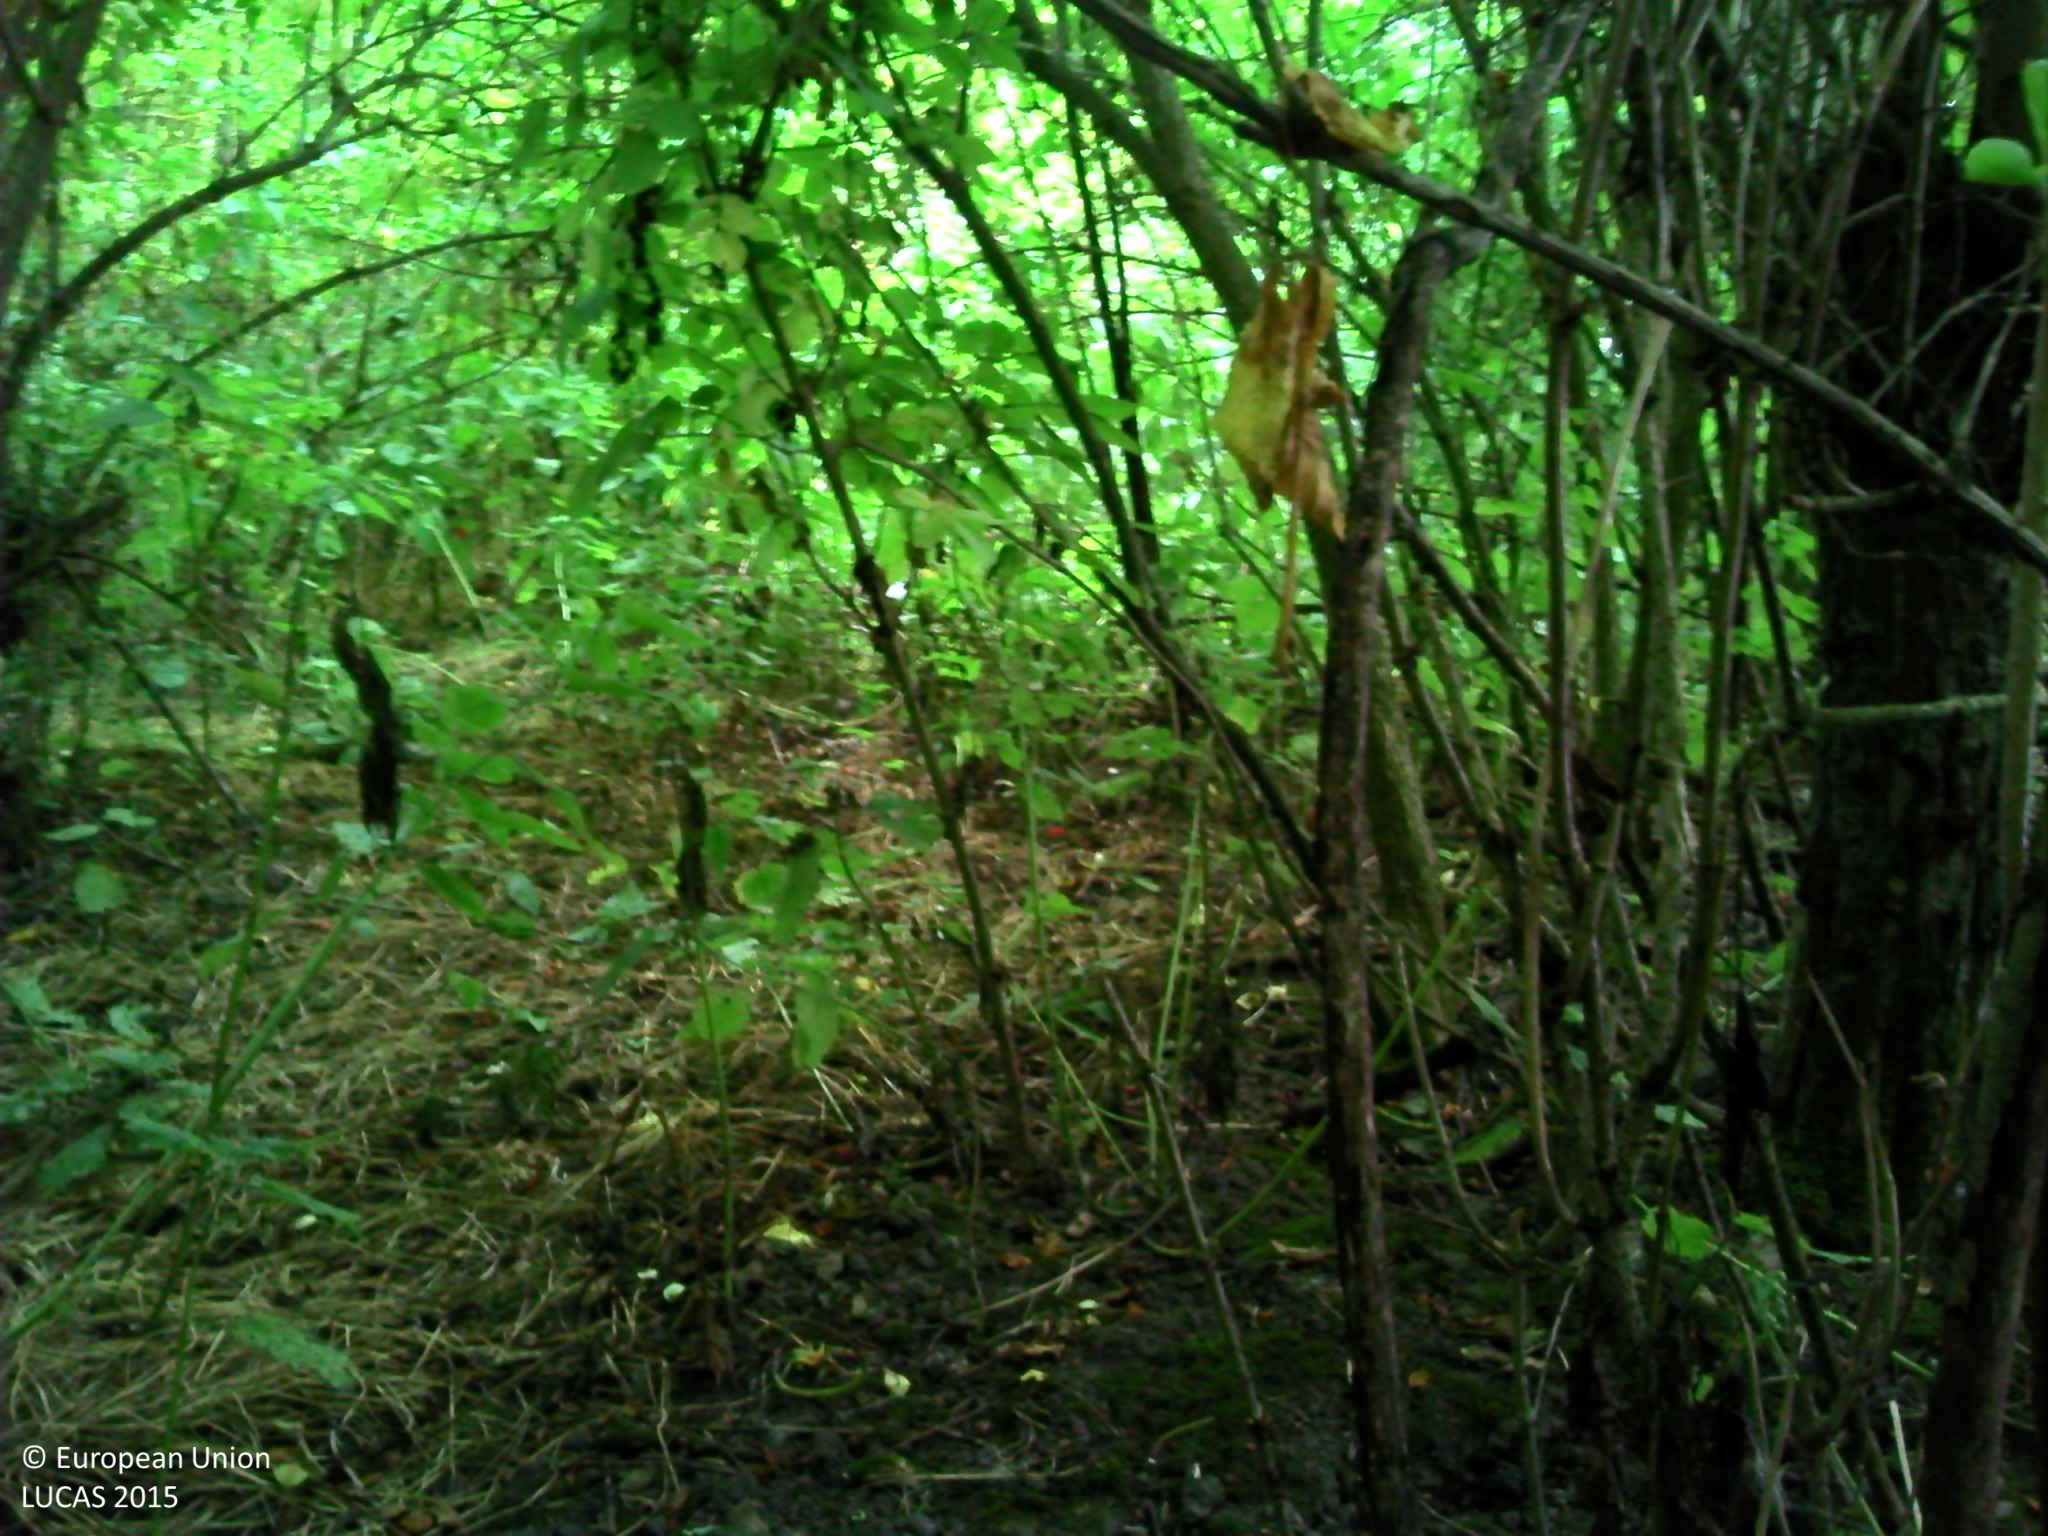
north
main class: Woodland
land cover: Broadleaved woodland
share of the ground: > 75 %
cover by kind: broadleaved forest trees 60 %, shrubs 20 %, herbaceous plants 5 %
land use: Semi-natural and natural areas not in use
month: August
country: FR
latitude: 50.8992
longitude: 2.0360
